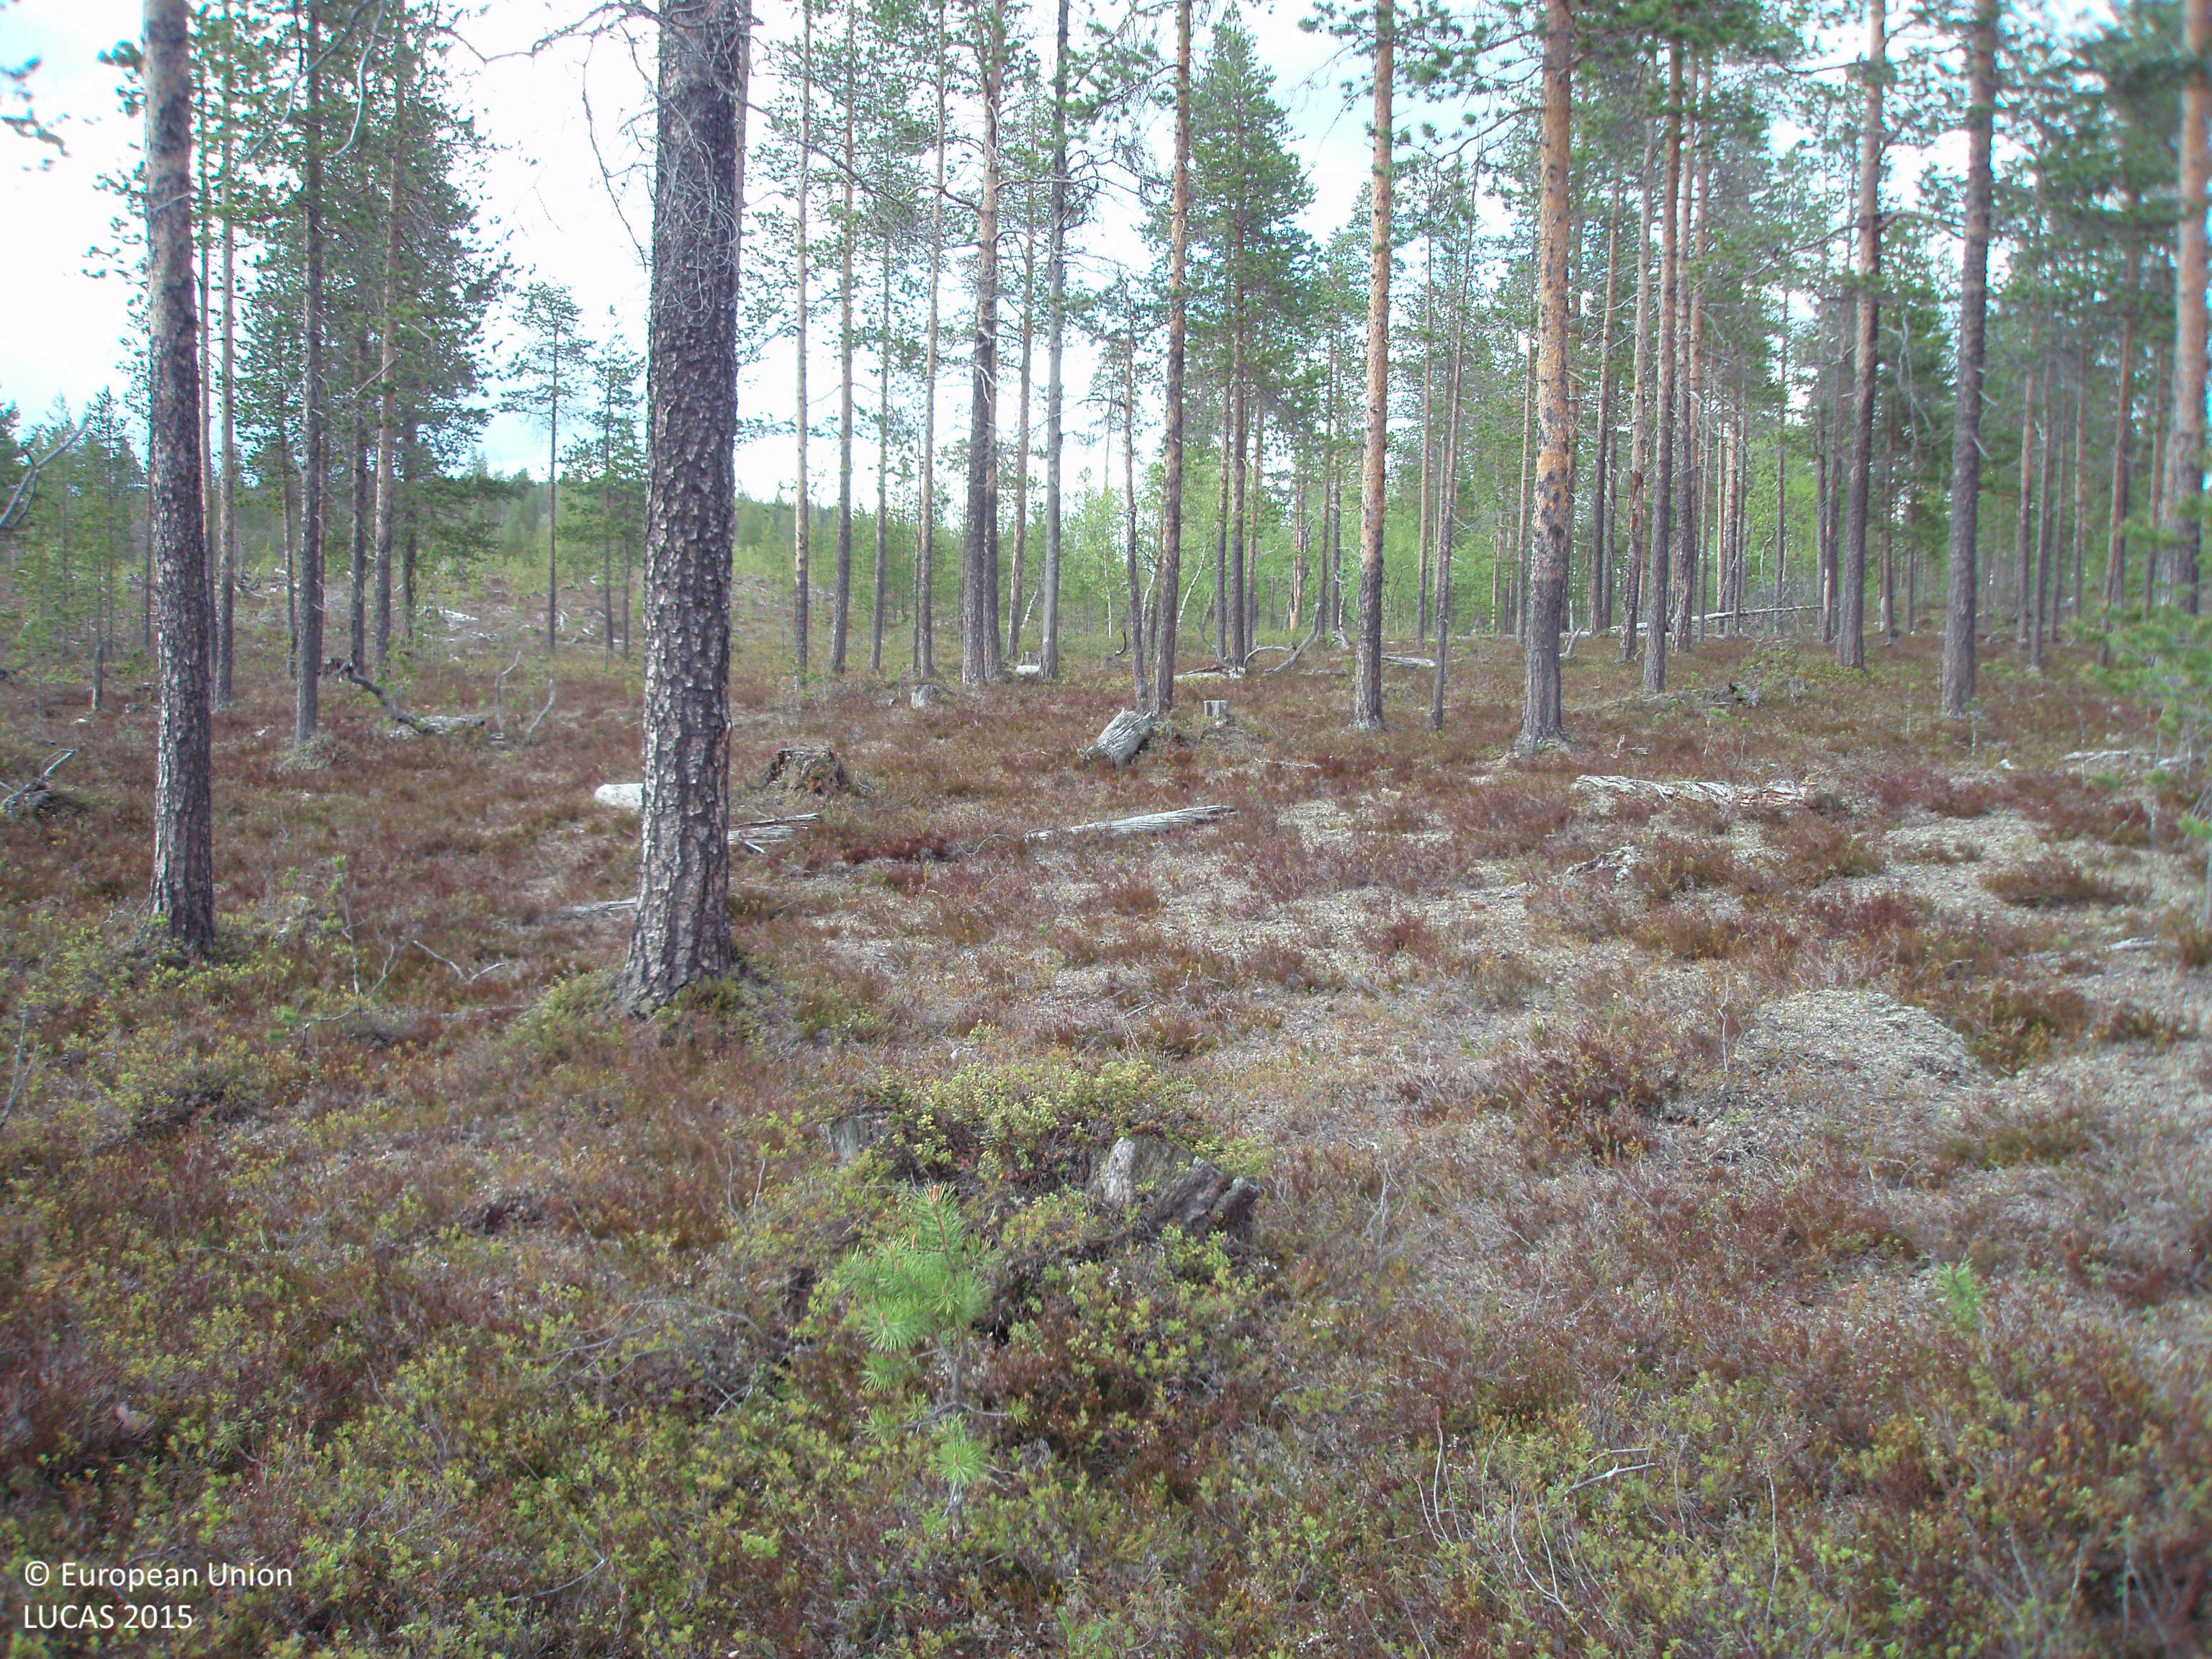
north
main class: Woodland
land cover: Pine dominated coniferous woodland
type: boreal forest
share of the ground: 25 - 50 %
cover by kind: shrubs 70 %, coniferous forest trees 25 %, lichens and mosses 5 %
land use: Forestry
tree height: > 5 m
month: June
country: FI
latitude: 68.4356
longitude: 27.8644
